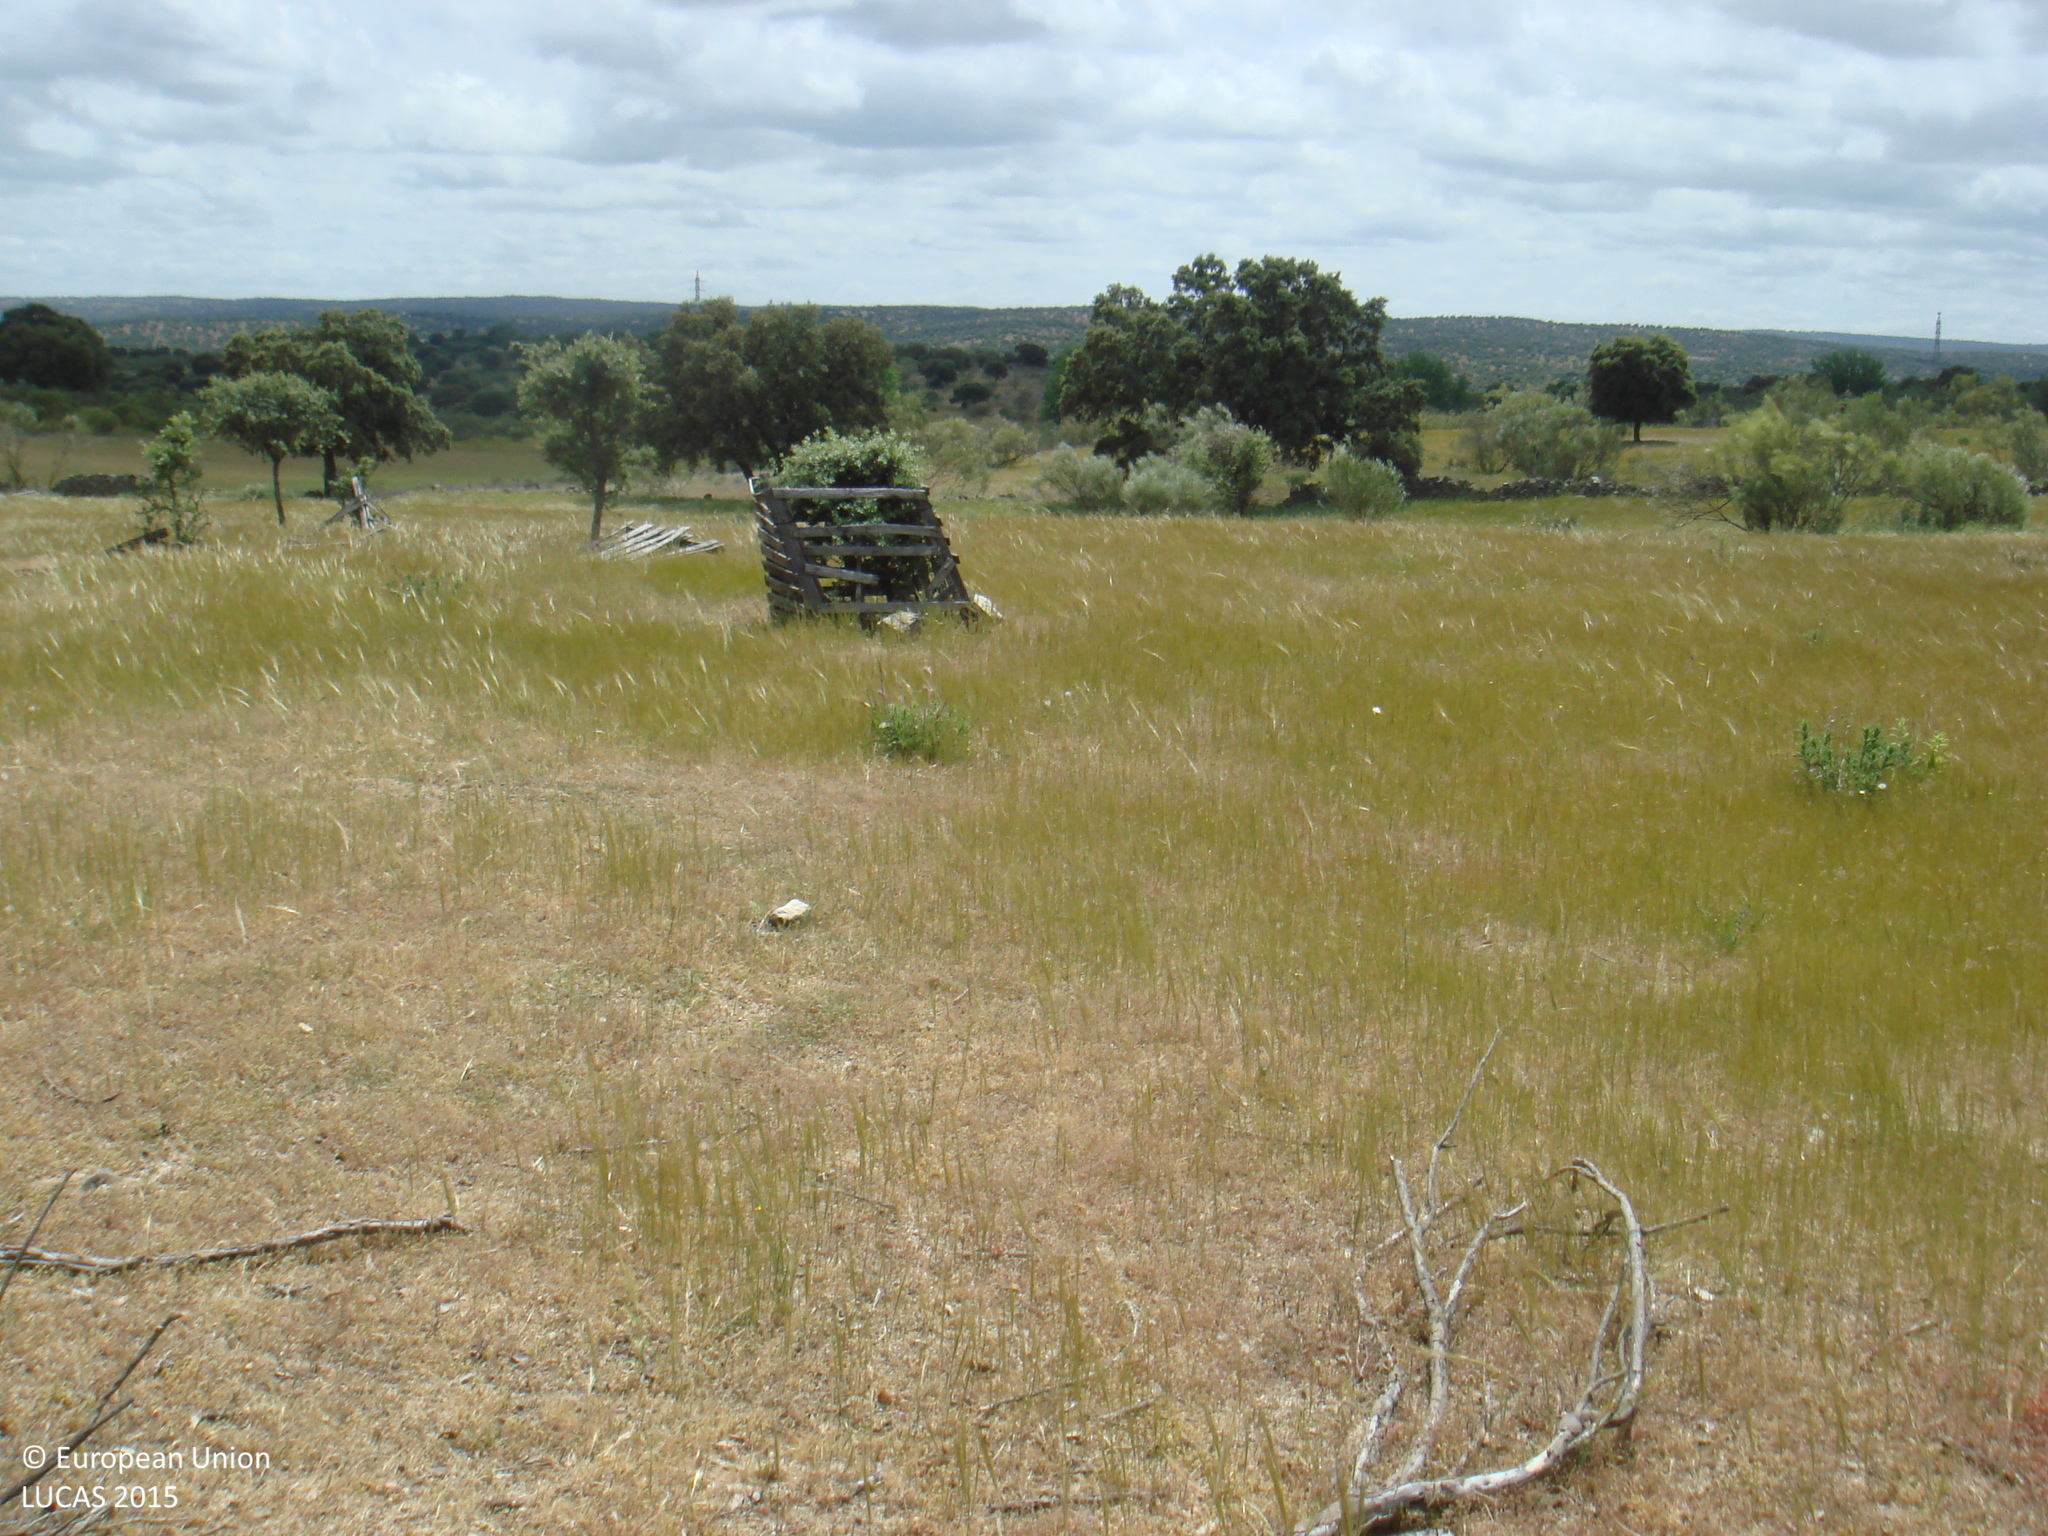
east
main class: Woodland
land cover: Broadleaved woodland
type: broadleaved evergreen forest
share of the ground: 25 - 50 %
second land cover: Shrubland without tree cover
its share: 10 - 25 %
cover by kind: broadleaved forest trees 40 %, herbaceous plants 40 %, shrubs 20 %
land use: Forestry
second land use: Agriculture (excluding fallow land and kitchen gardens)
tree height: > 5 m
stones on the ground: < 10 %
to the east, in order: Broadleaved woodland; Shrubland without tree cover; Fences; Dry stone walls; Grass margins; Tracks; Grass margins; Fences; Grassland without tree/shrub cover; Grassland with sparse tree/shrub cover
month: May
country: ES
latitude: 38.4408
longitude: -4.6755
